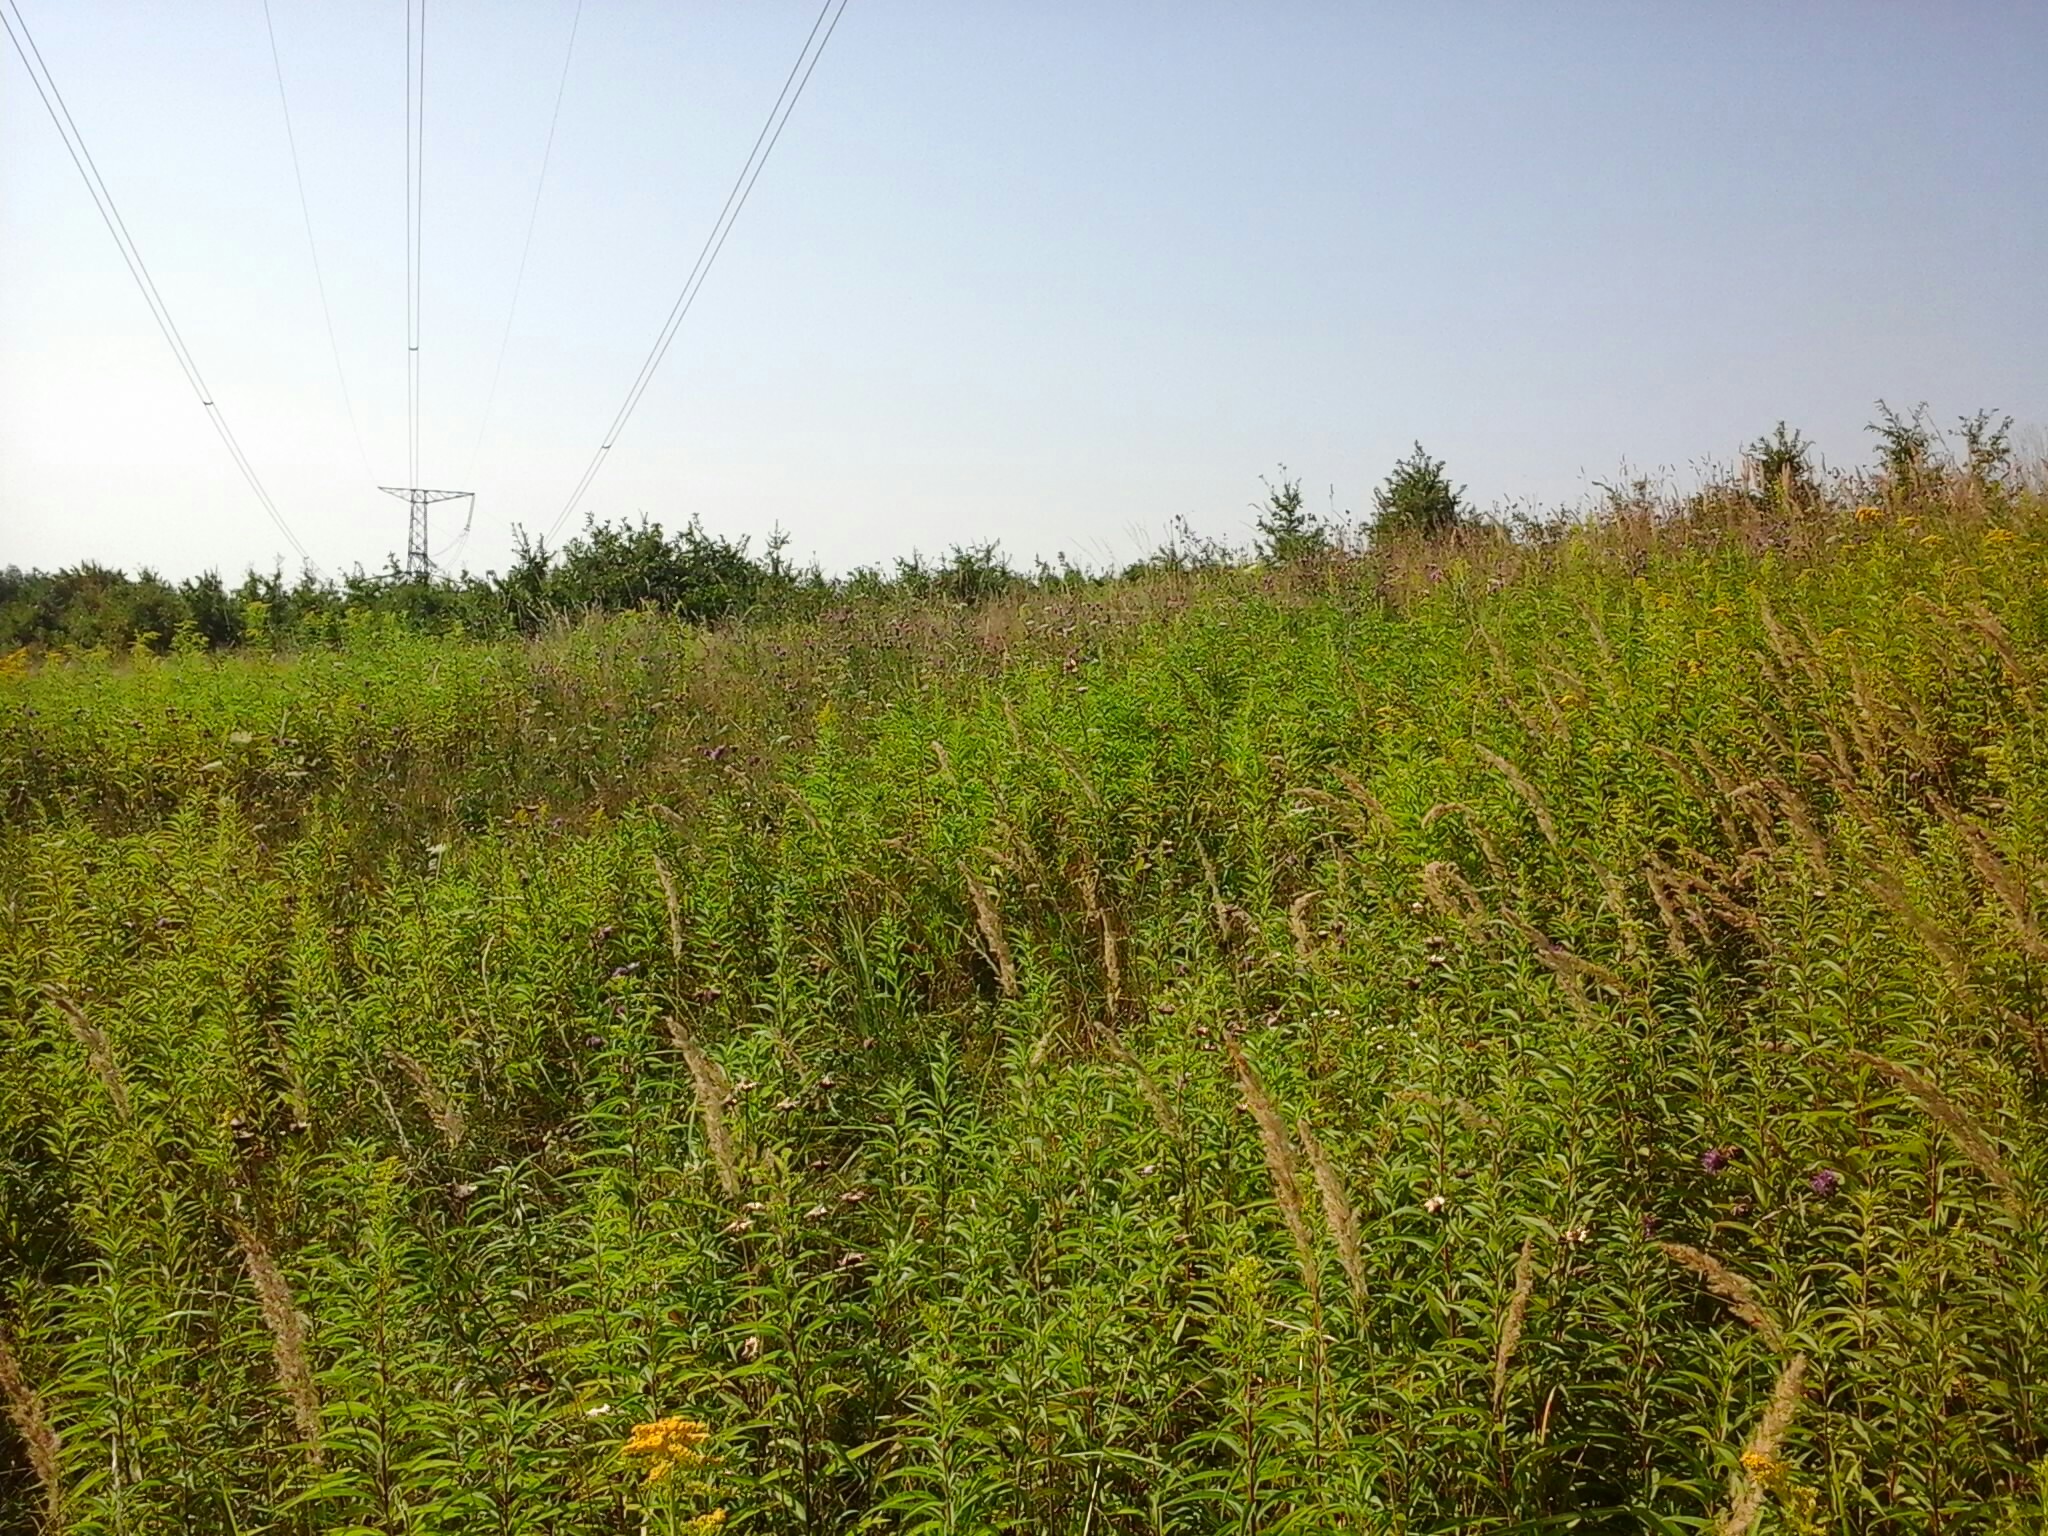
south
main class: Grassland
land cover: Grassland without tree/shrub cover
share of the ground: > 75 %
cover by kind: herbaceous plants 95 %, shrubs 5 %
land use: Agriculture (excluding fallow land and kitchen gardens)
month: August
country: HU
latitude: 47.4515
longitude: 17.9015
